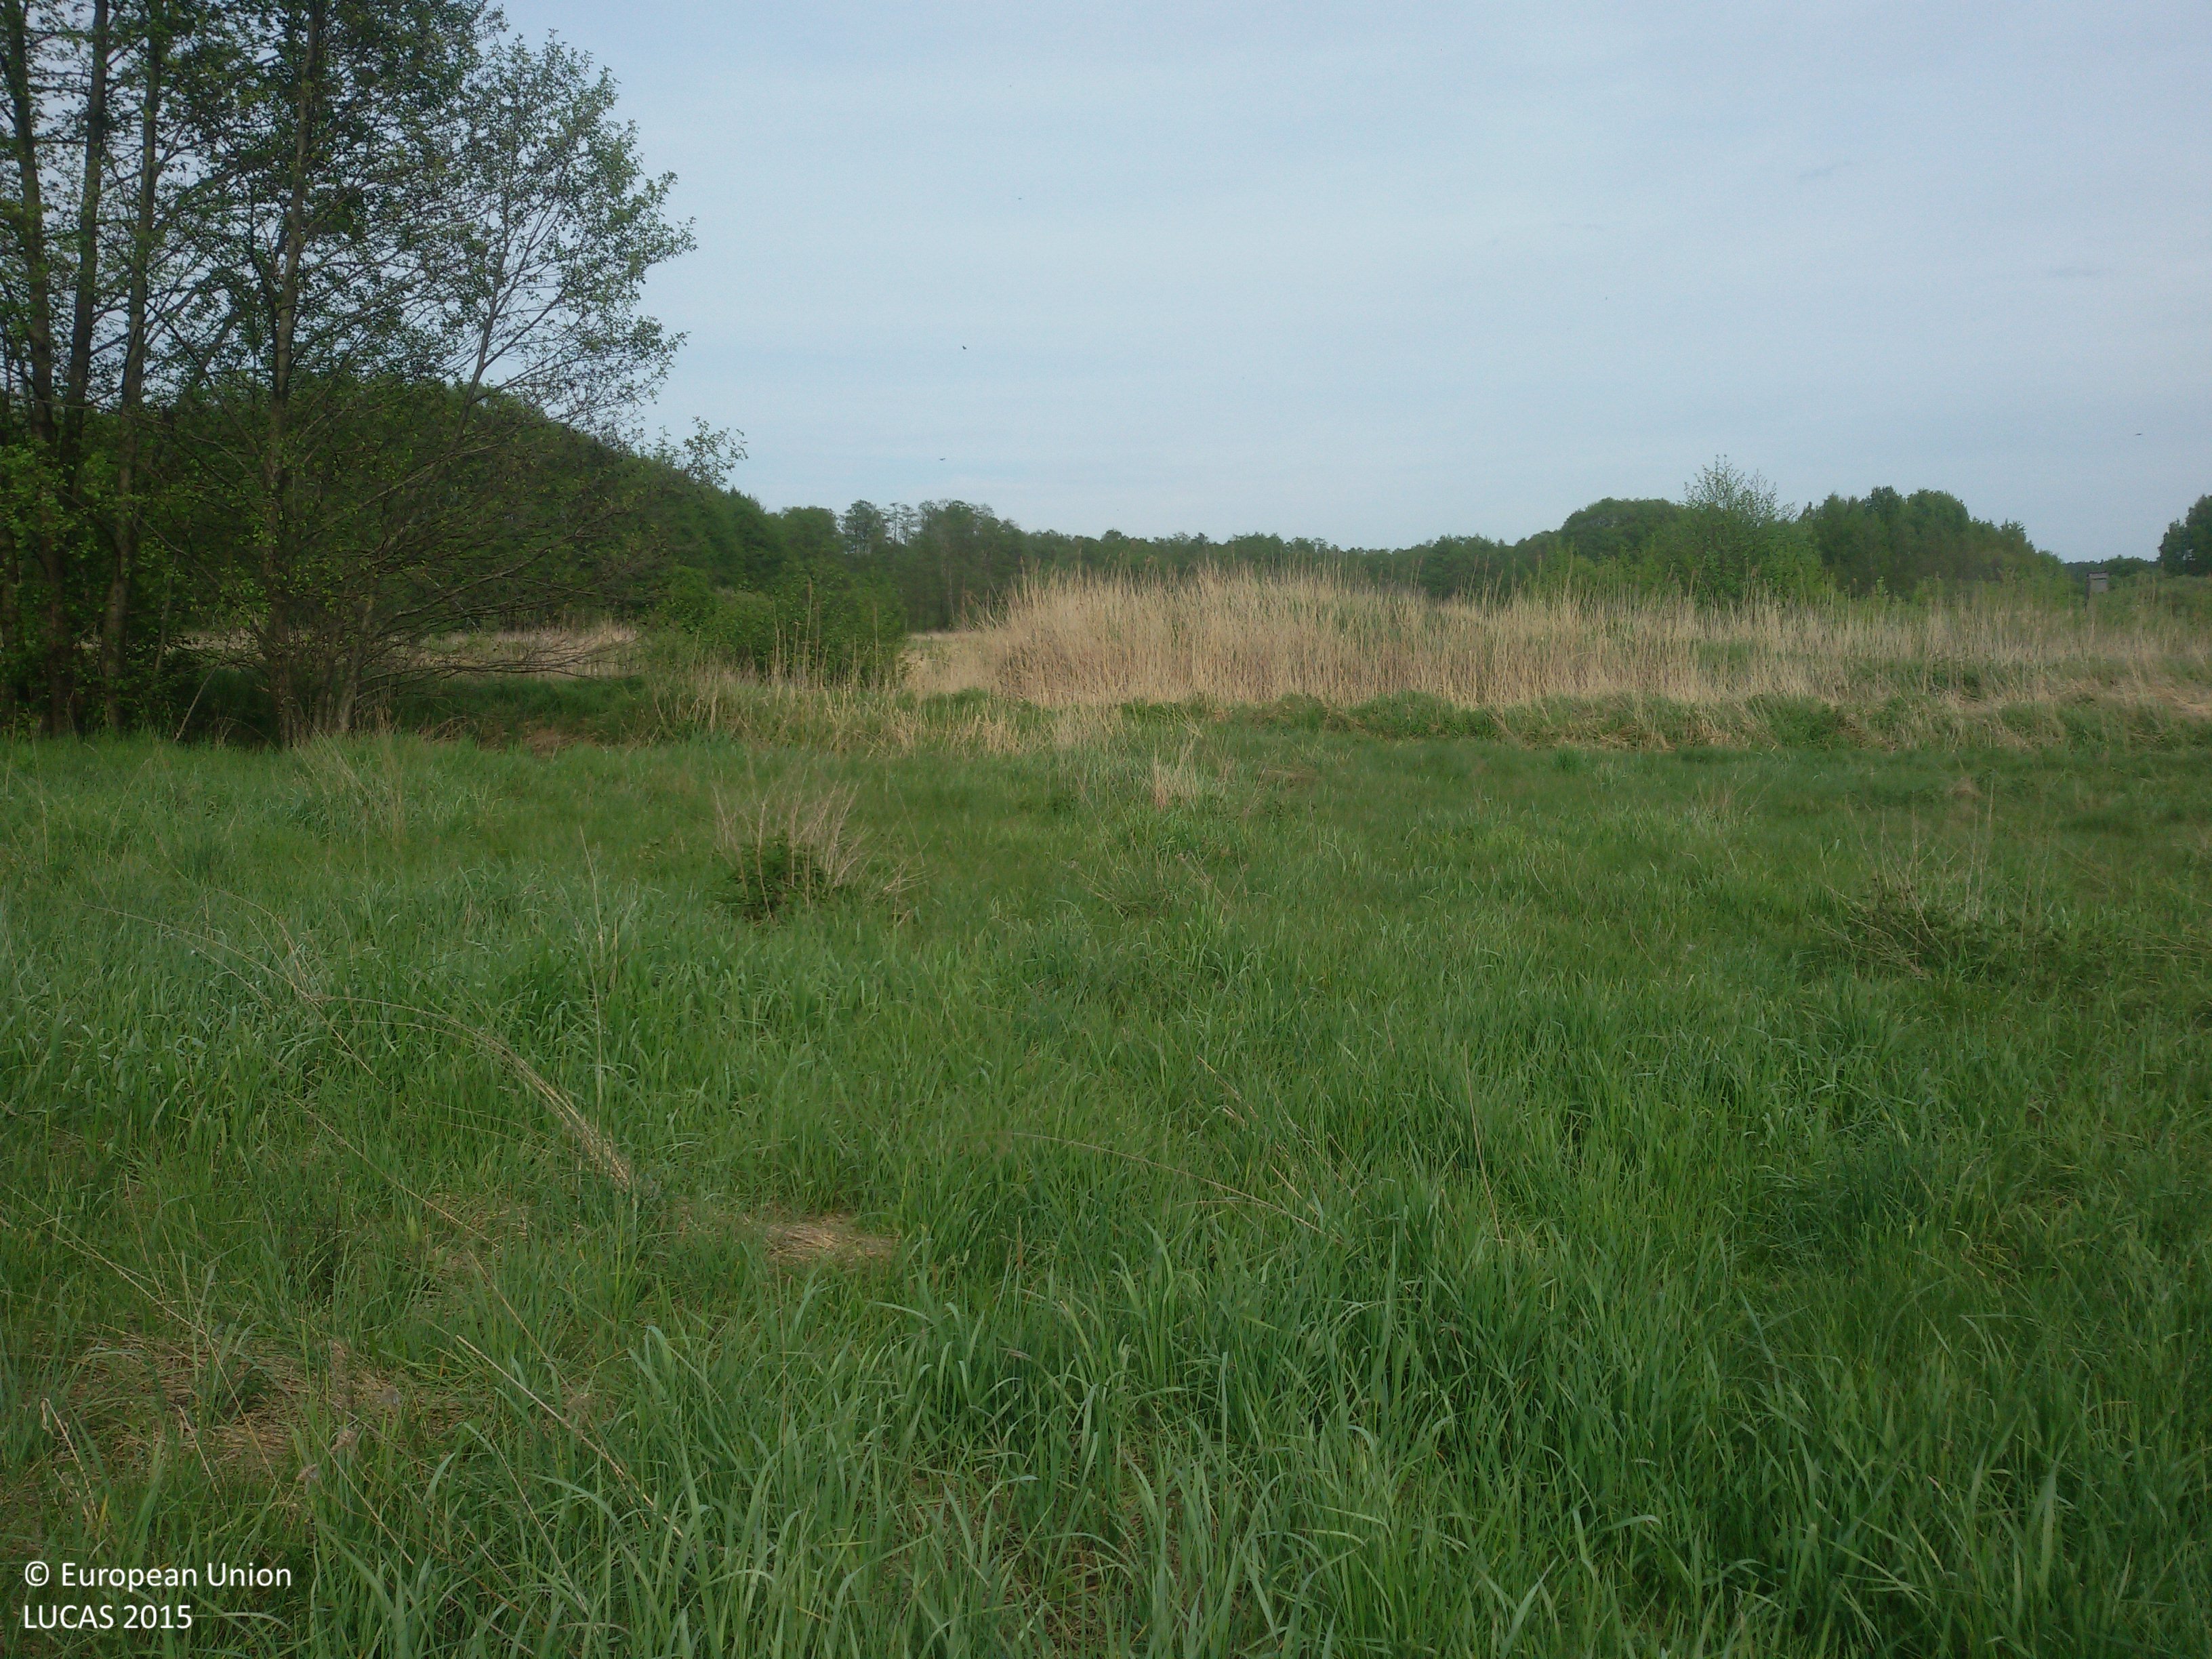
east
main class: Grassland
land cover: Grassland without tree/shrub cover
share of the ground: > 75 %
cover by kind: herbaceous plants 100 %
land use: Agriculture (excluding fallow land and kitchen gardens)
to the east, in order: Grassland without tree/shrub cover; Ditches and canals; Spontaneously vegetated surfaces; Inland fresh water bodies; Grassland with sparse tree/shrub cover; Ditches and canals; Grassland without tree/shrub cover; Ditches and canals; Grassland without tree/shrub cover
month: May
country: PL
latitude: 52.0147
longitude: 20.7507
